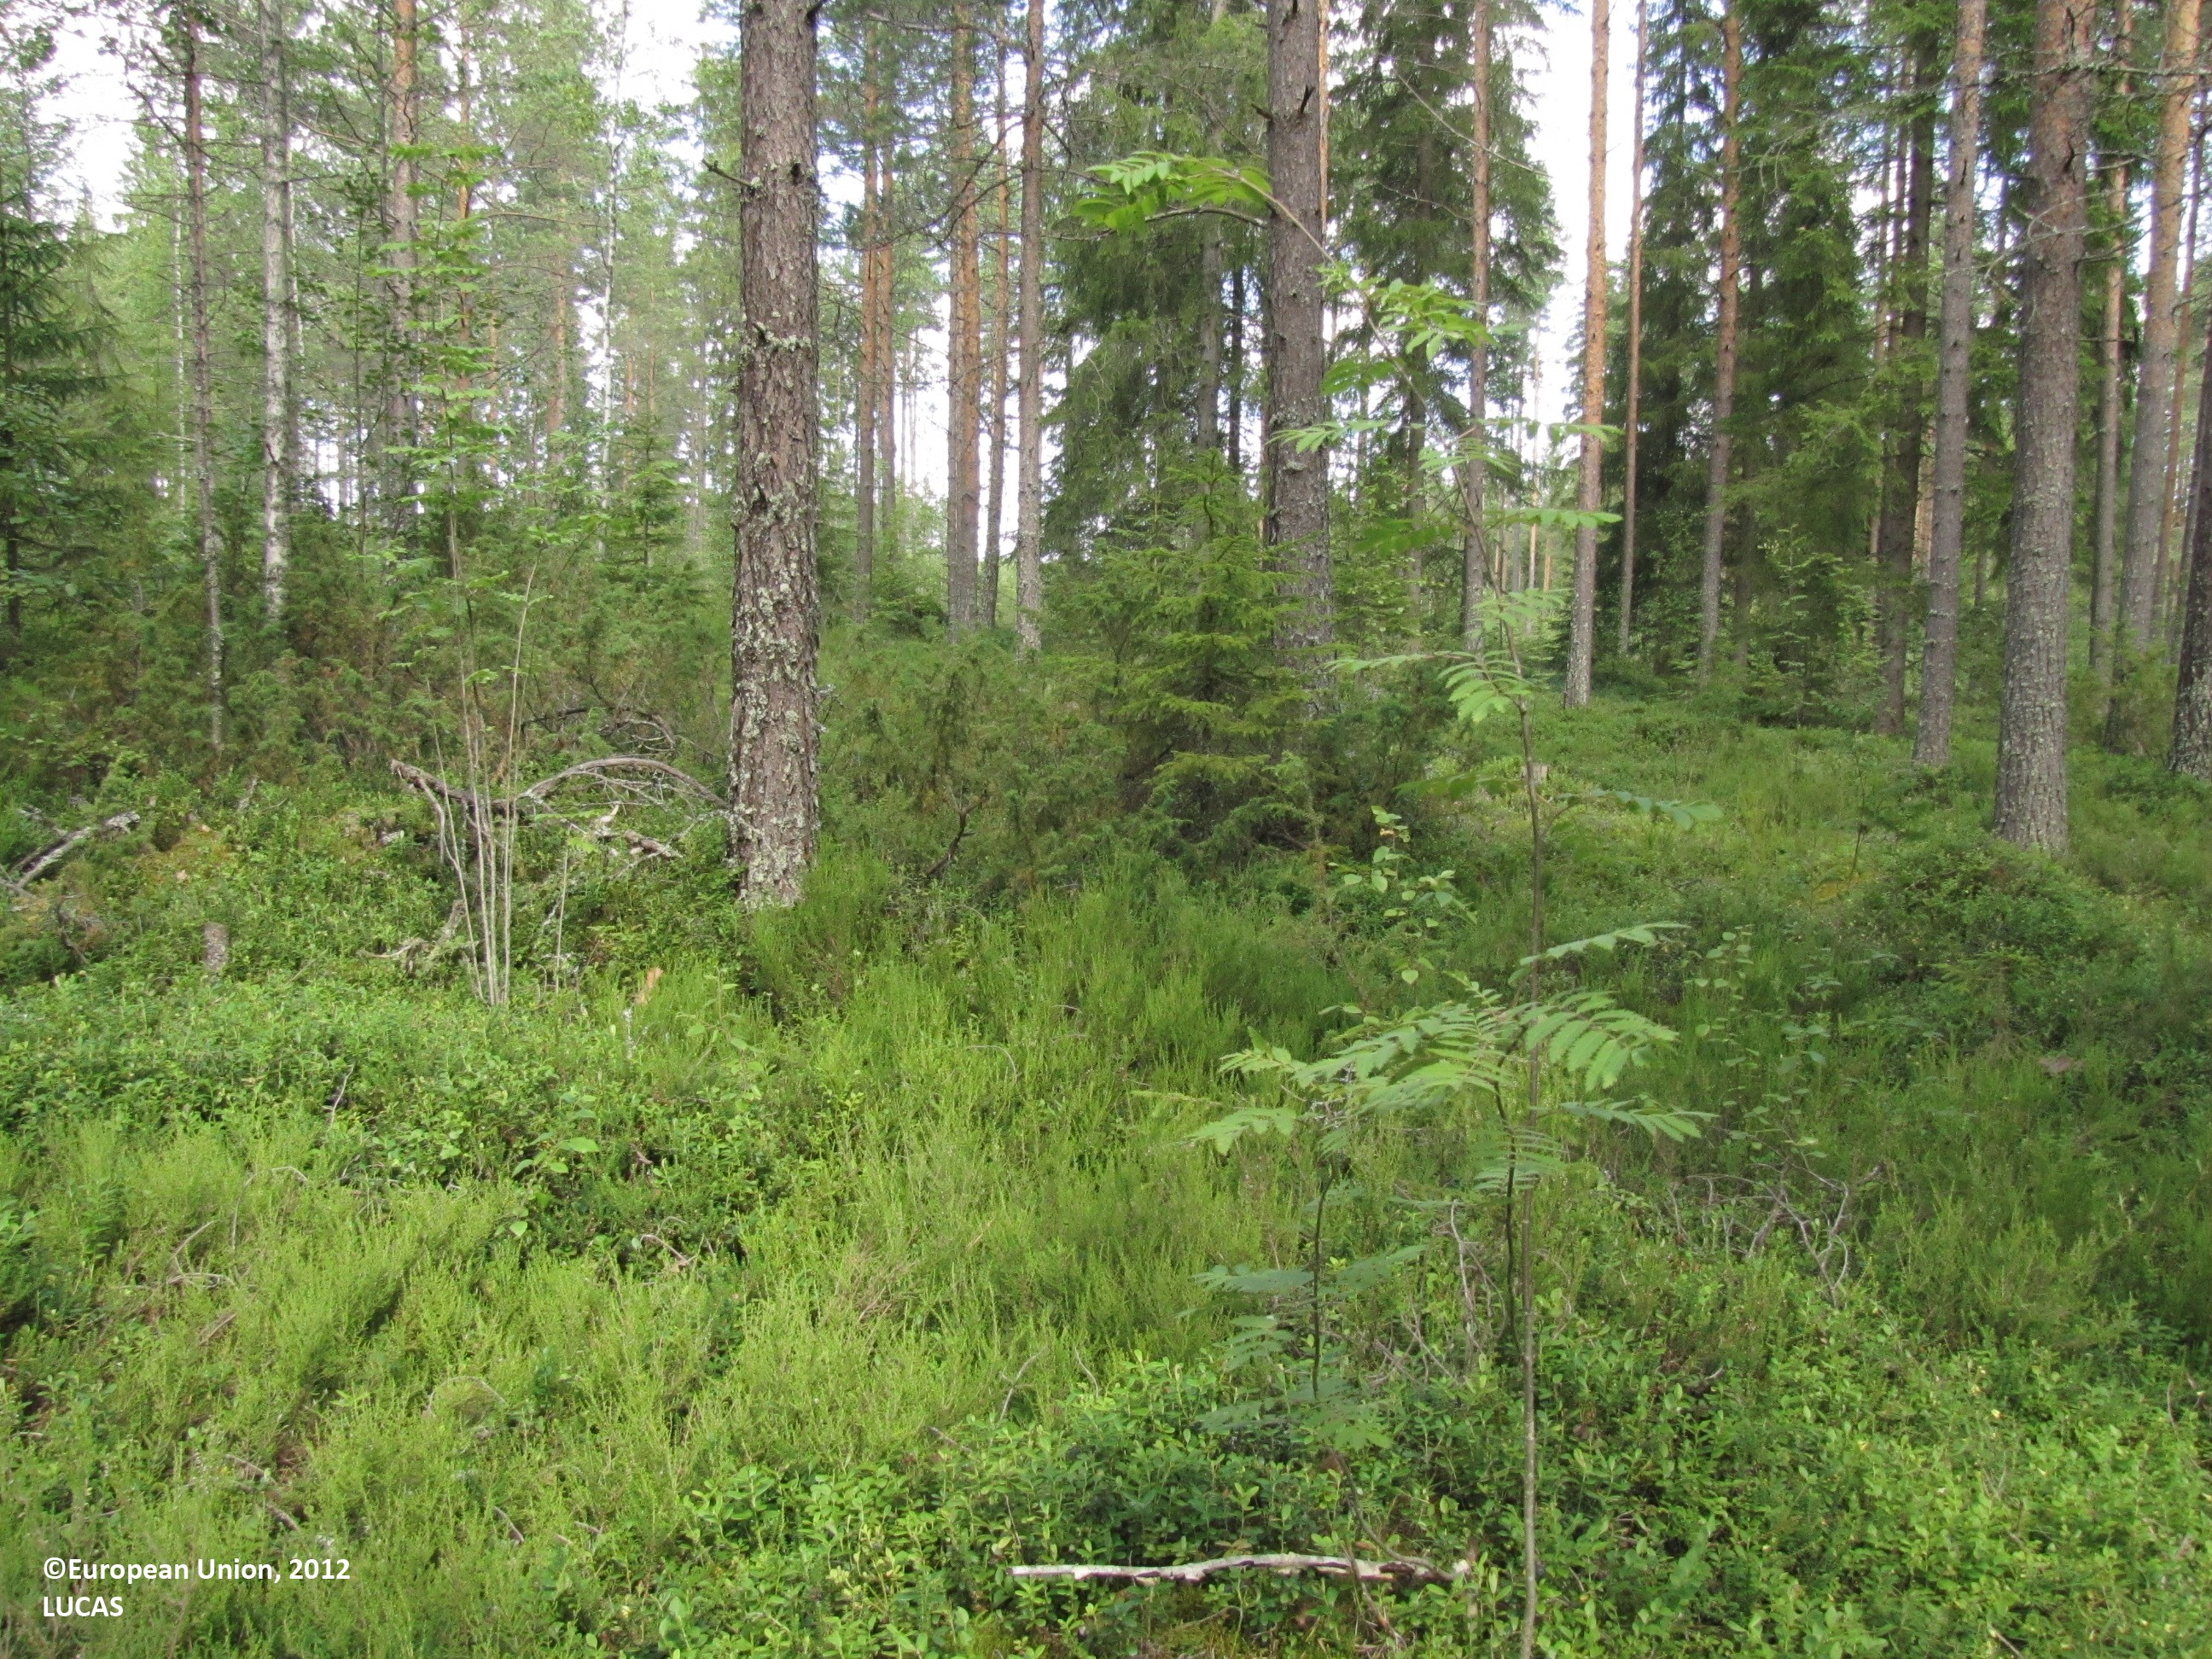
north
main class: Woodland
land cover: Other coniferous woodland
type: boreal forest
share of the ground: 50 - 75 %
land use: Forestry
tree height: > 5 m
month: July
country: FI
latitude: 62.2112
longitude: 23.2006
